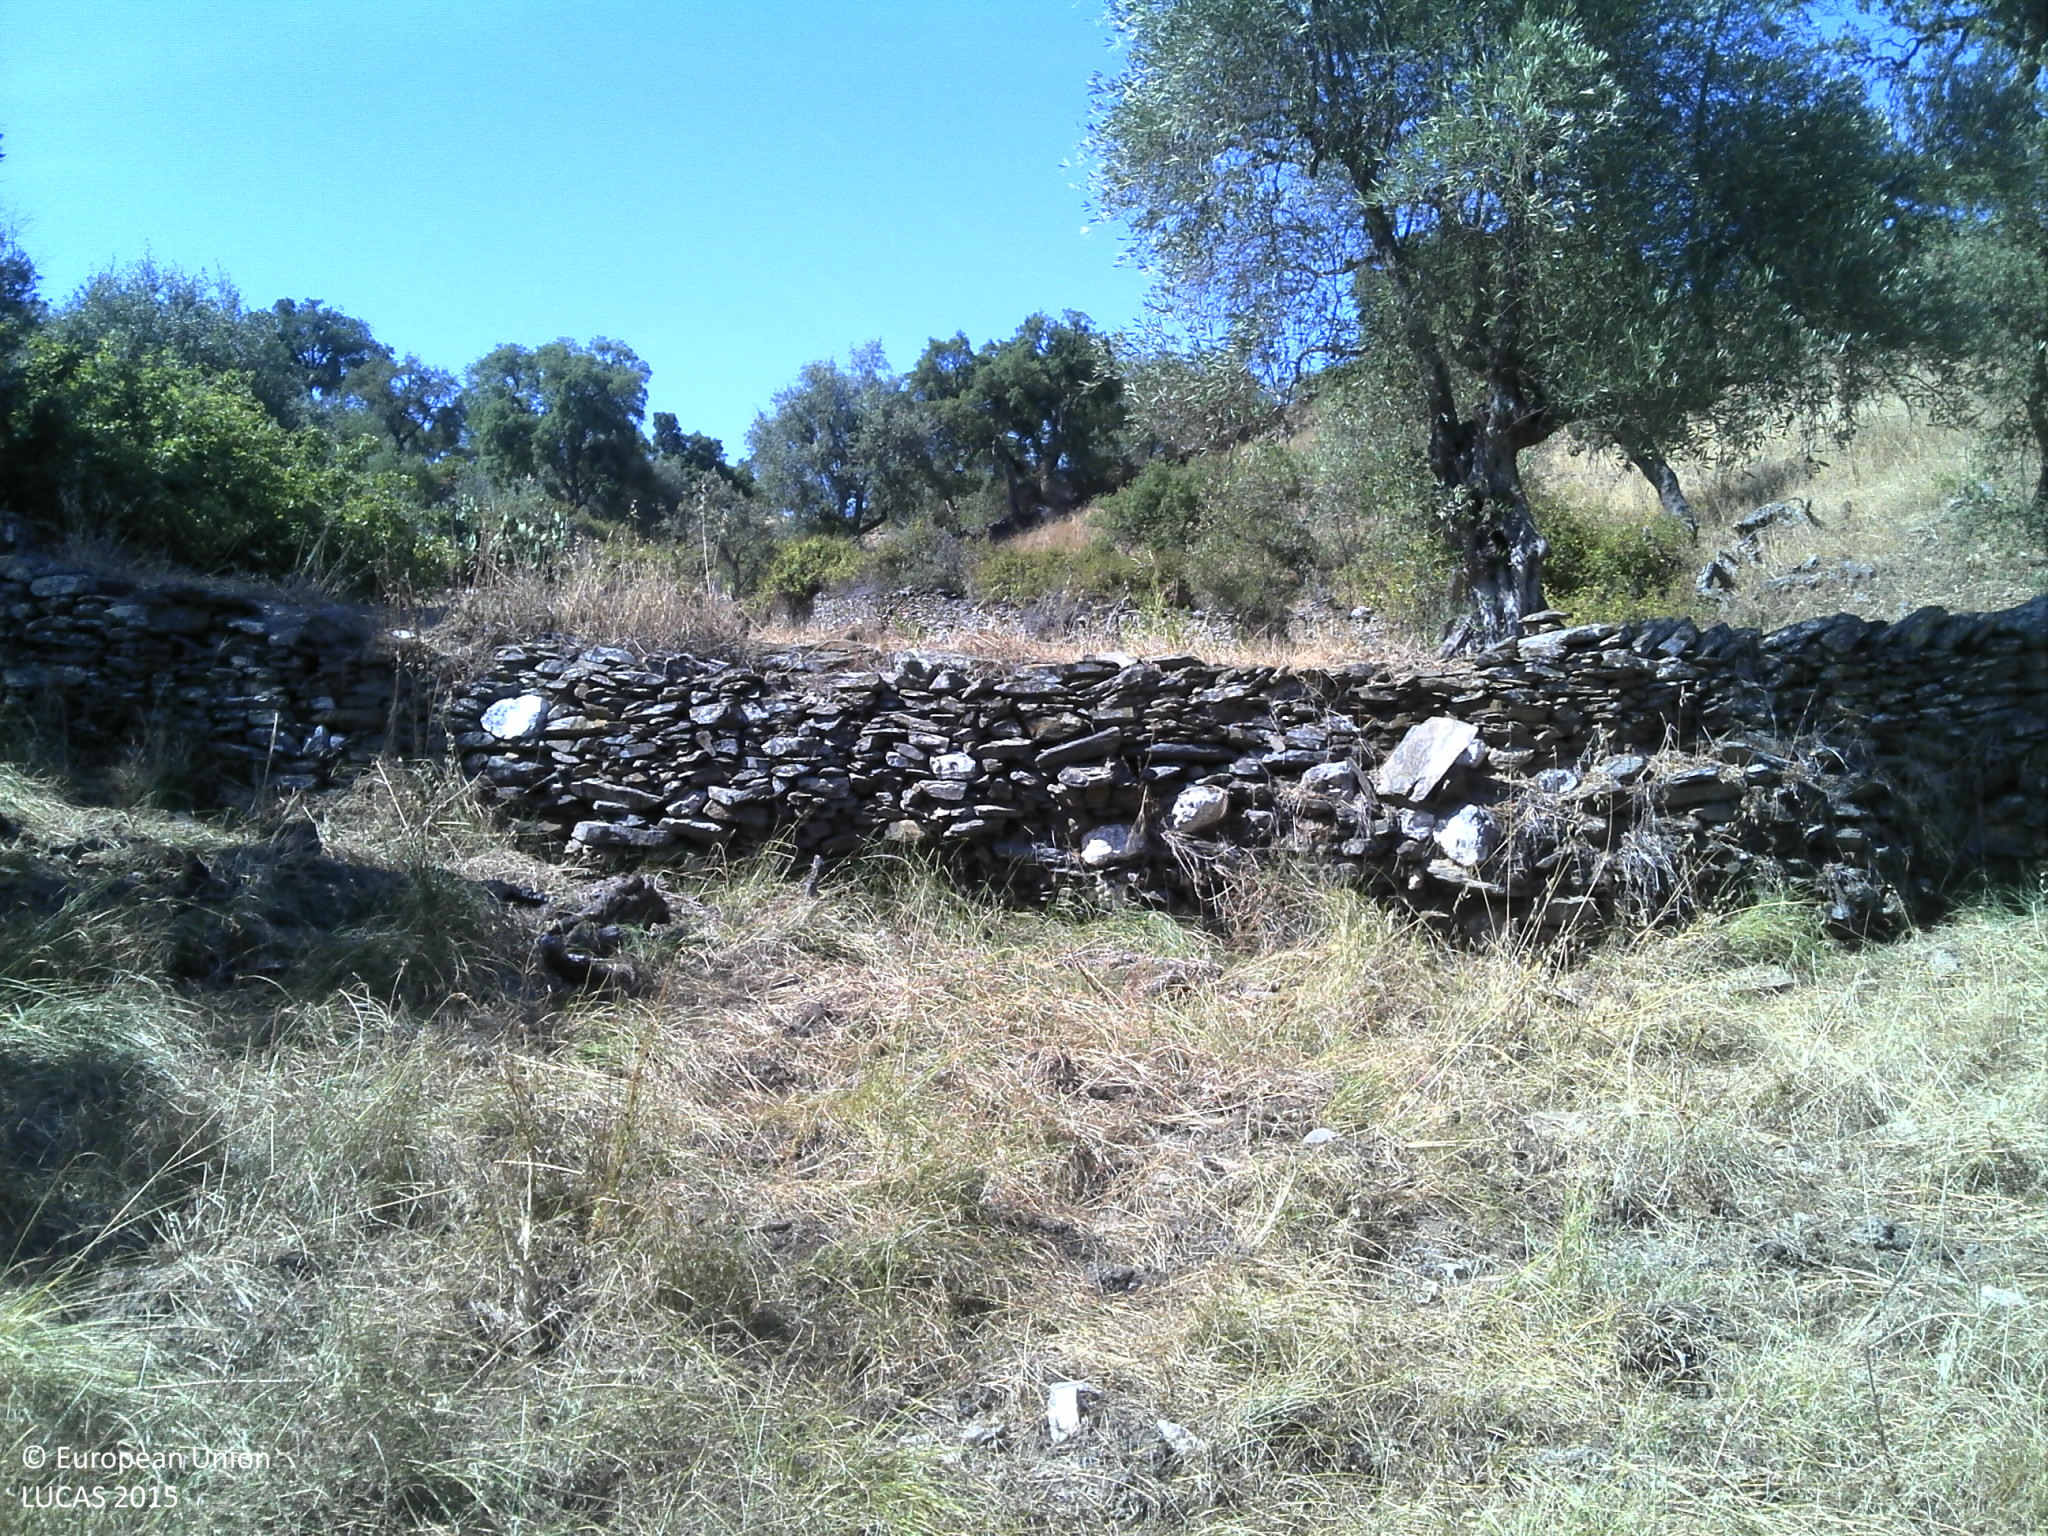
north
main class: Woodland
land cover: Broadleaved woodland
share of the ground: 25 - 50 %
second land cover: Spontaneously vegetated surfaces
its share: 25 - 50 %
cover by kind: herbaceous plants 40 %, broadleaved forest trees 35 %, unconsolidated bare surface 20 %, shrubs 5 %
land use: Forestry
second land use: Agriculture (excluding fallow land and kitchen gardens)
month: July
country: PT
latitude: 39.6645
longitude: -7.5711
